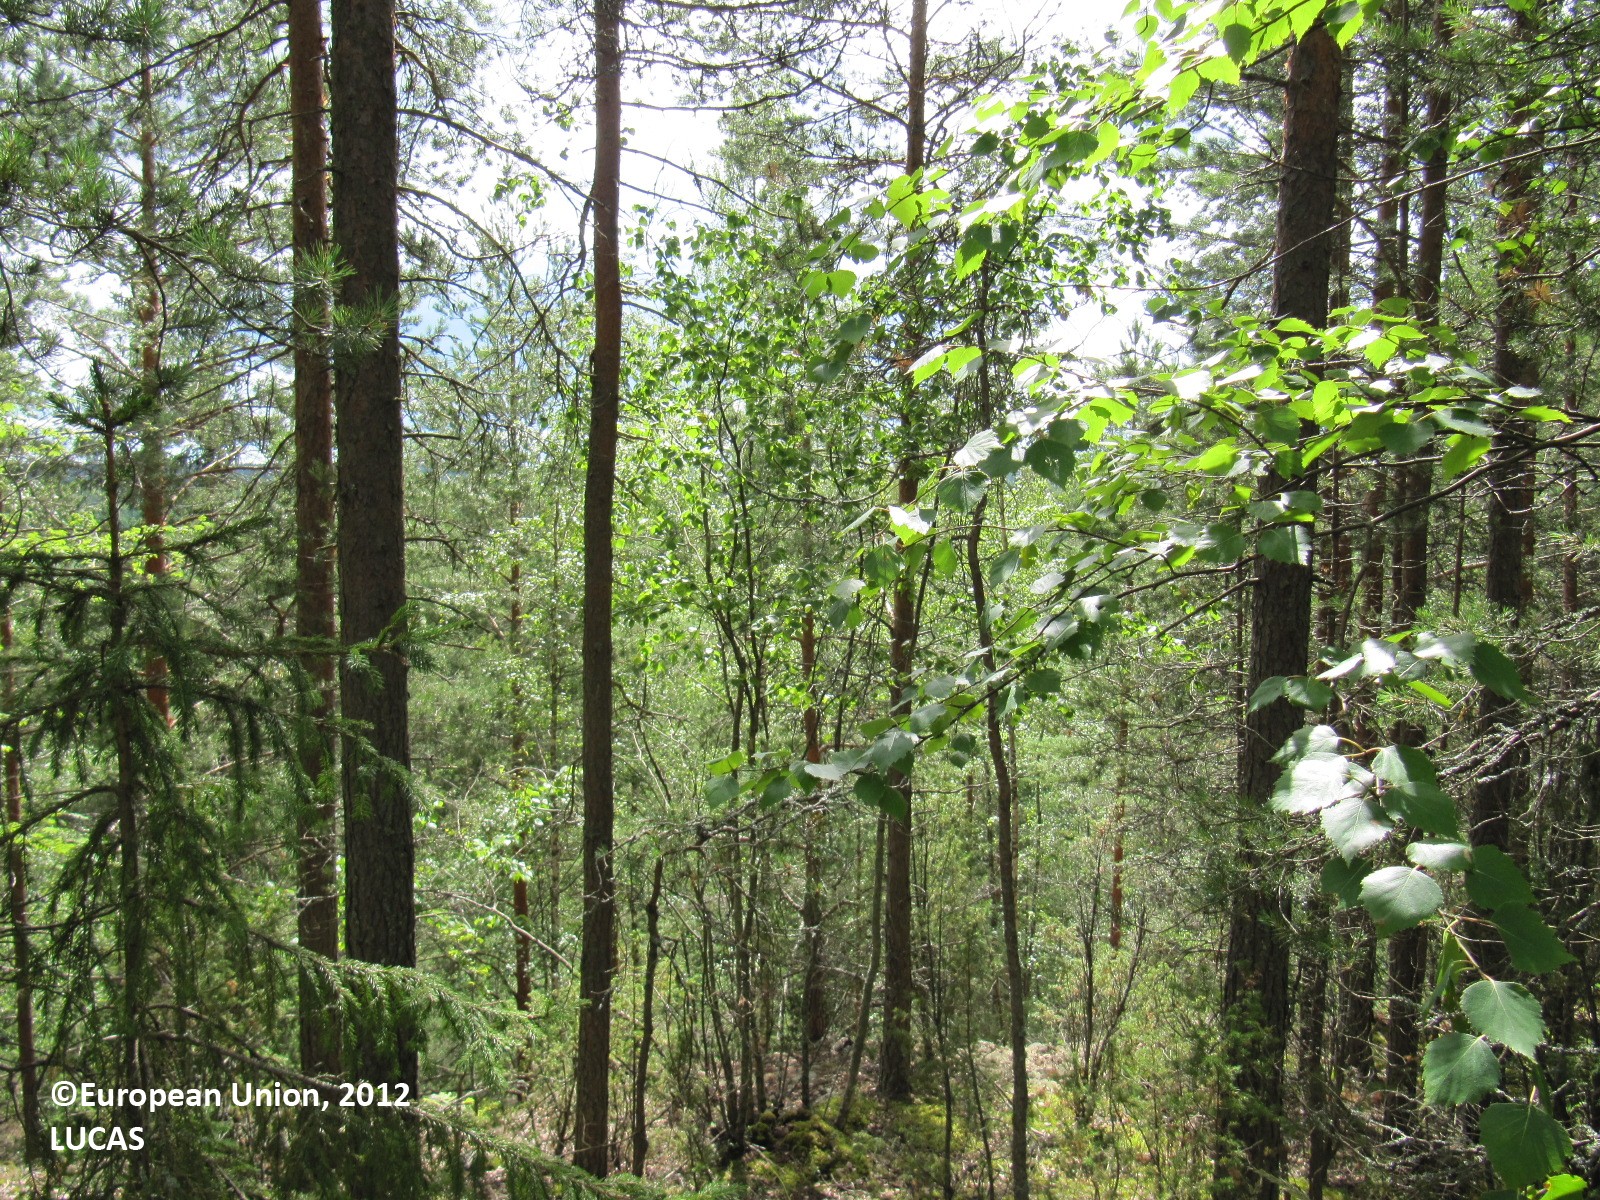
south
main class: Woodland
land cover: Pine dominated mixed woodland
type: boreal forest
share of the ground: 50 - 75 %
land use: Forestry
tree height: > 5 m
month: July
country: FI
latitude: 60.7533
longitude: 24.6209
